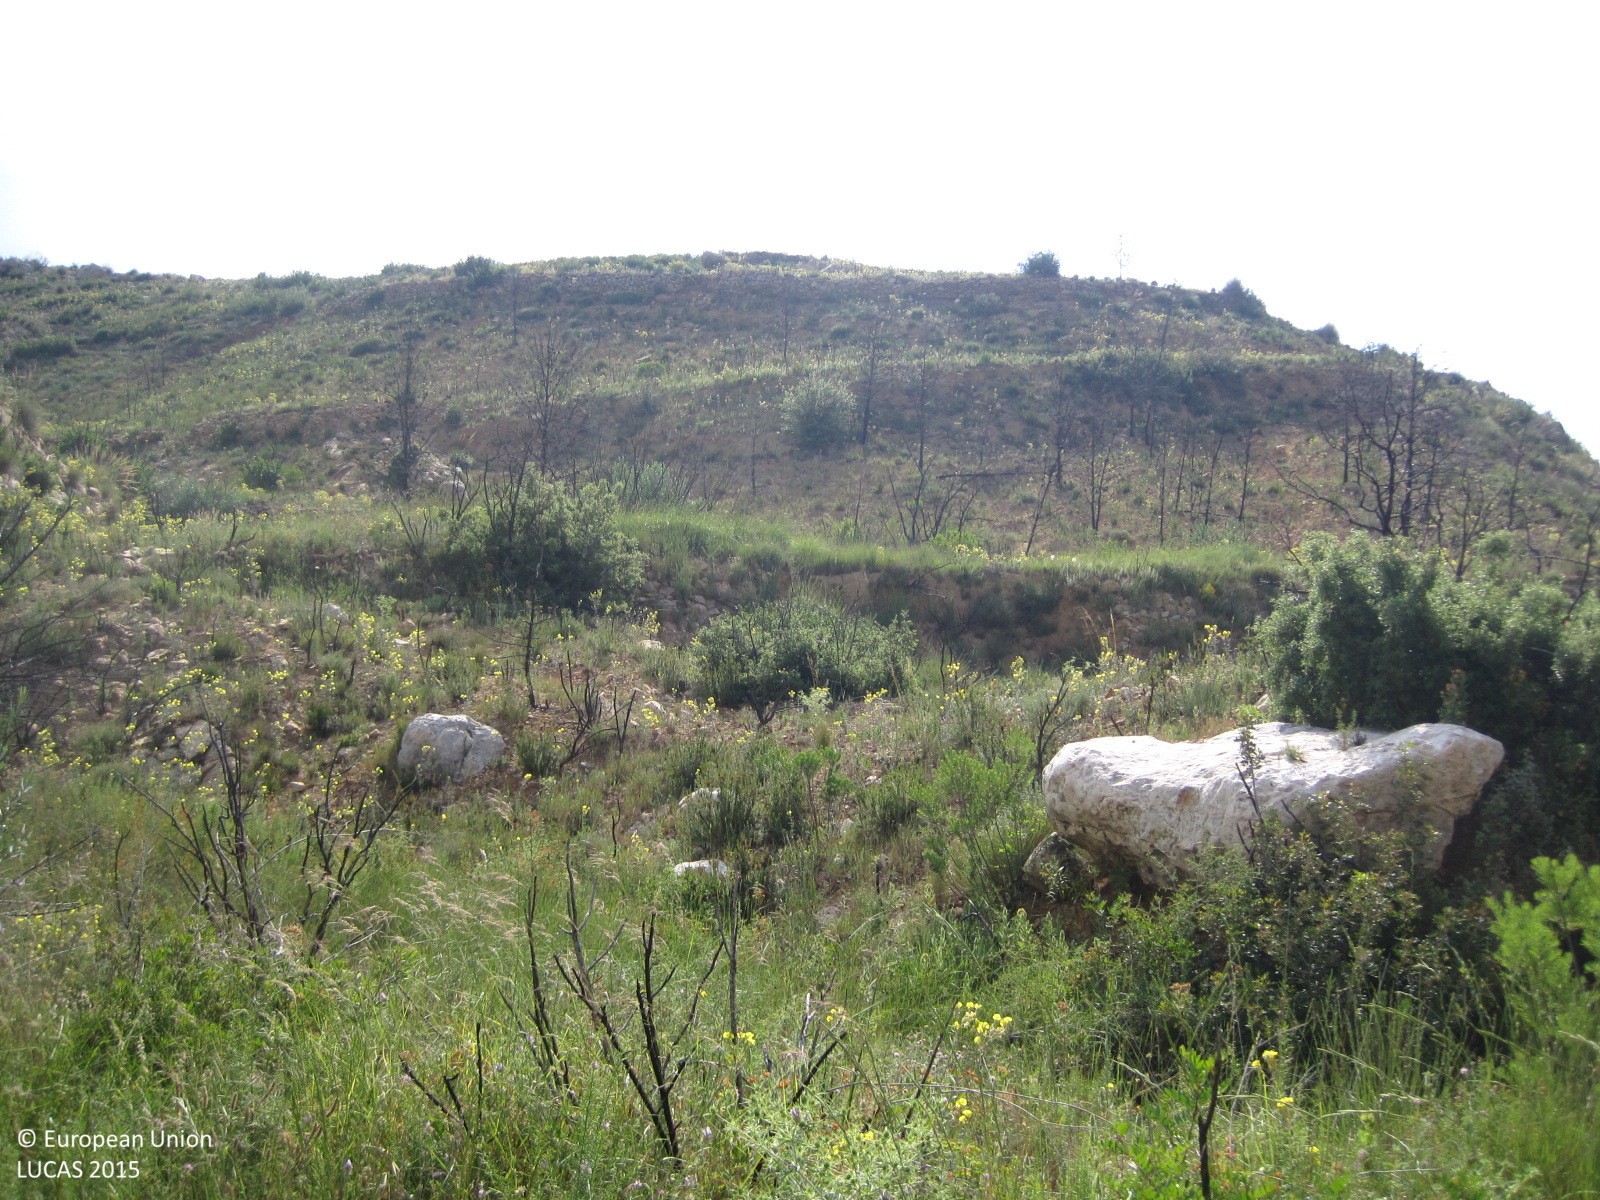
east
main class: Grassland
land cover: Grassland with sparse tree/shrub cover
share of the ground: > 75 %
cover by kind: herbaceous plants 85 %, shrubs 10 %, broadleaved forest trees 5 %
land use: Semi-natural and natural areas not in use
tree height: < 5 m
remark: Burnt area
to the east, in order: Grassland with sparse tree/shrub cover; Shrubland without tree cover; Grassland with sparse tree/shrub cover; Shrubland without tree cover; Dry stone walls; Shrubland without tree cover; Dry stone walls; Grassland with sparse tree/shrub cover; Tracks; Shrubland with sparse tree cover; Shruby margins; Tracks; Dry stone walls; Shrubland without tree cover; Olive groves; Shrubland with sparse tree cover; Olive groves; Shrubland with sparse tree cover
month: June
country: ES
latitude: 39.3000
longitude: -0.8398
